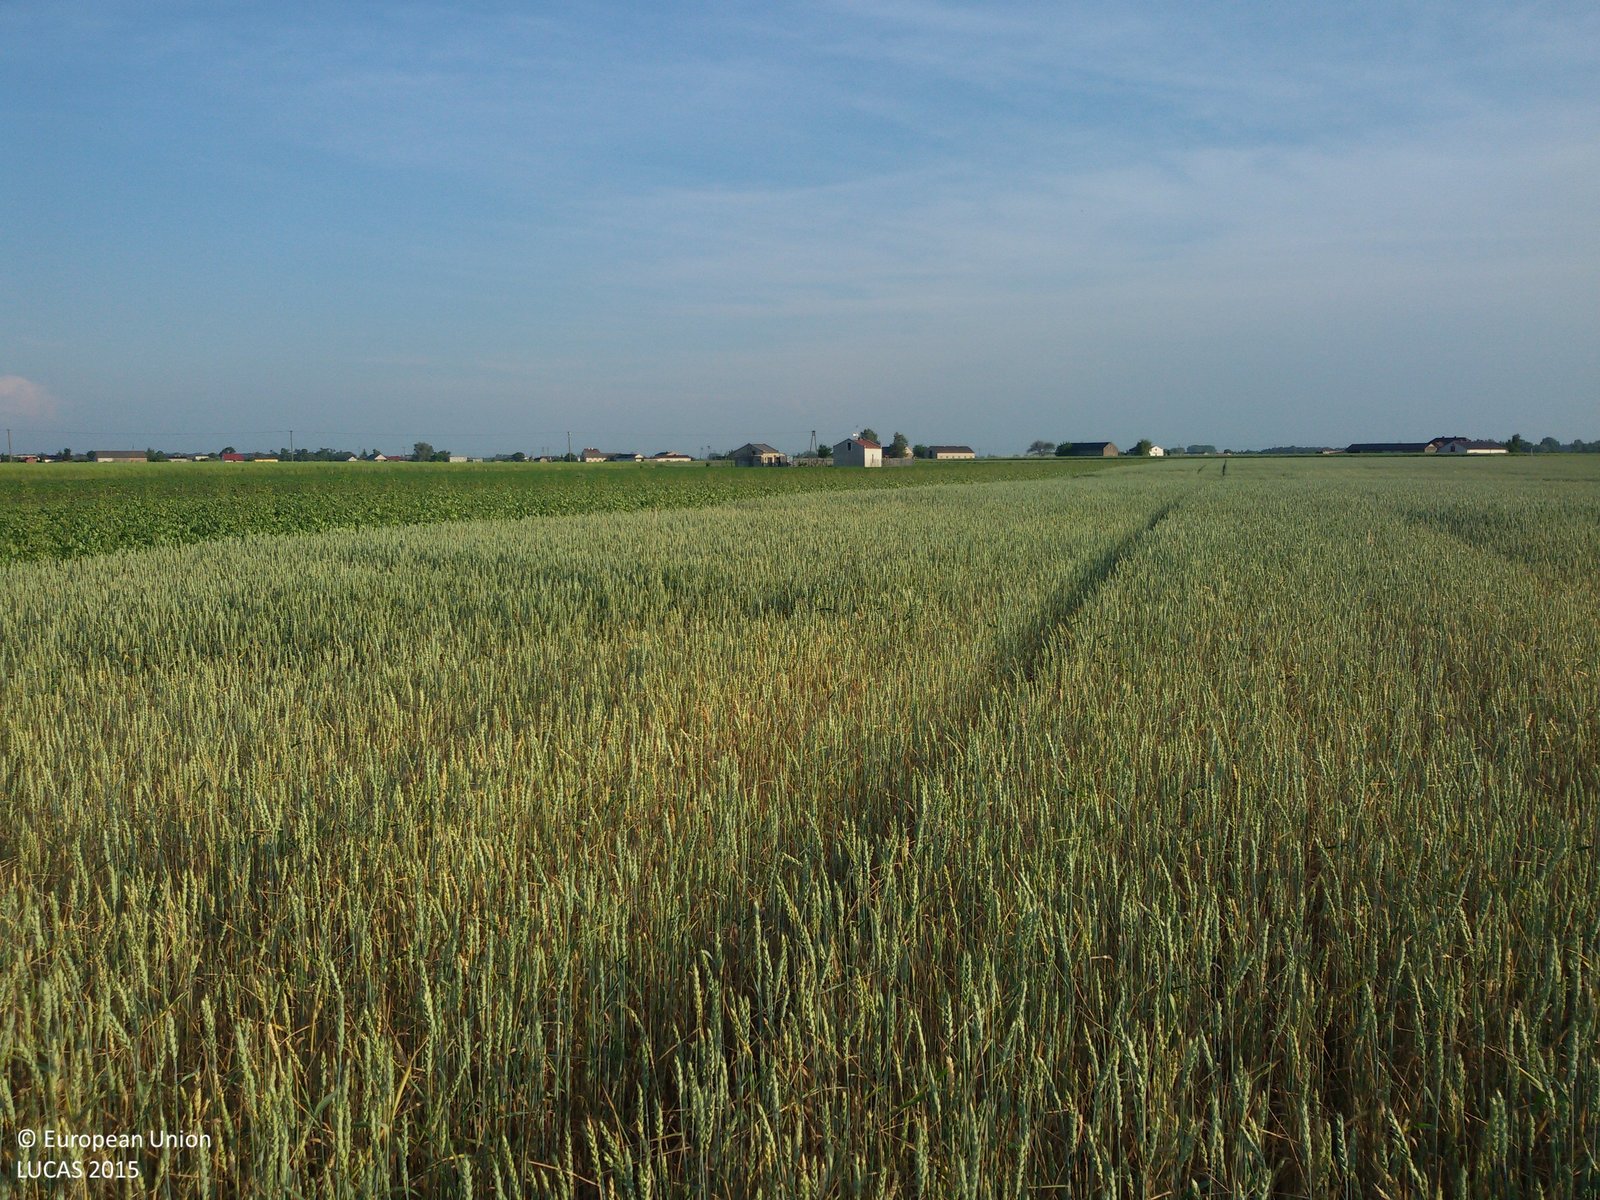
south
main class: Cropland
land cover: Common wheat
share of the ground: > 75 %
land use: Agriculture (excluding fallow land and kitchen gardens)
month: June
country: PL
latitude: 52.5192
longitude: 19.0574
